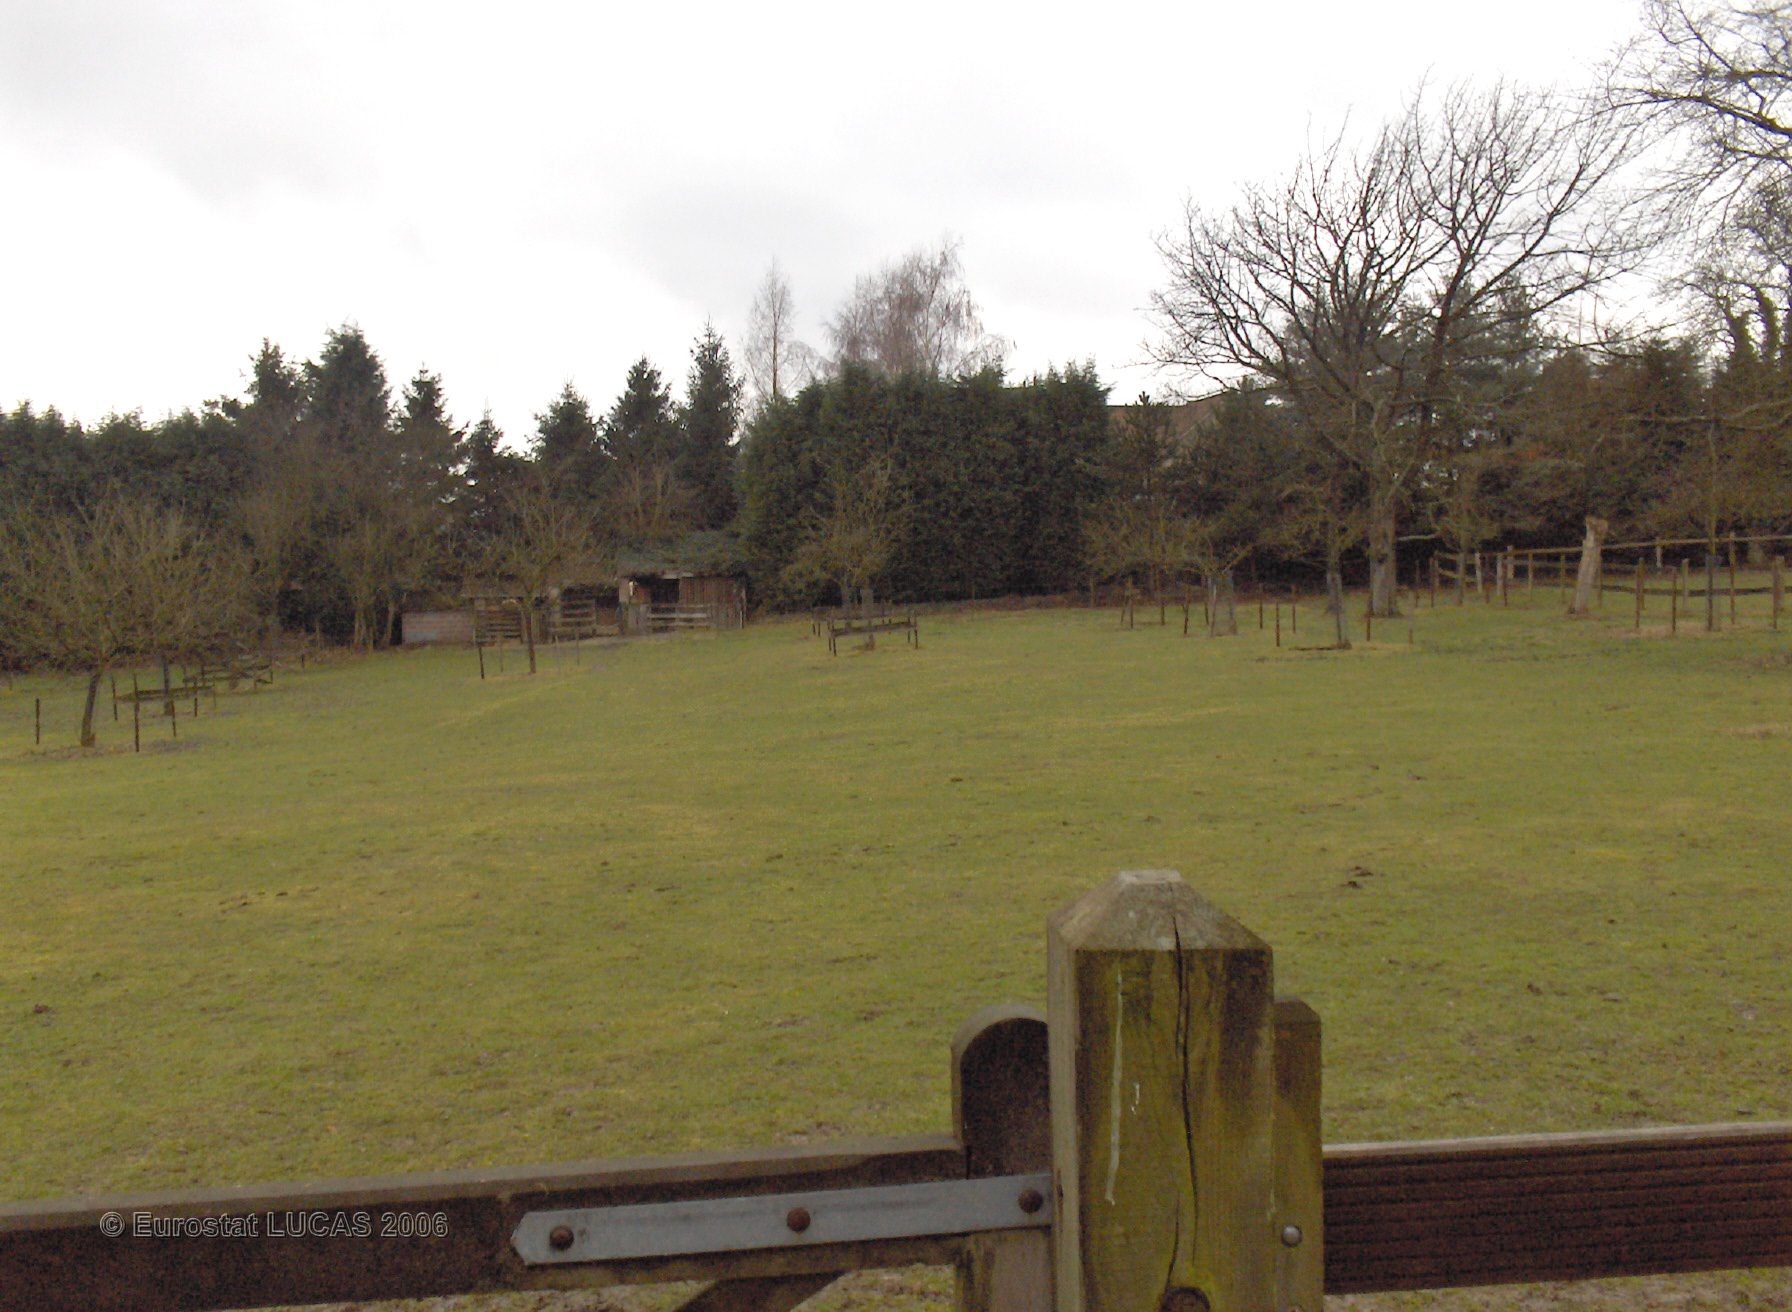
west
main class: Grassland
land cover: Grassland with sparse tree/shrub cover
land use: Agriculture (excluding fallow land and kitchen gardens)
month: February
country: BE
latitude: 50.7715
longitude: 4.4797
